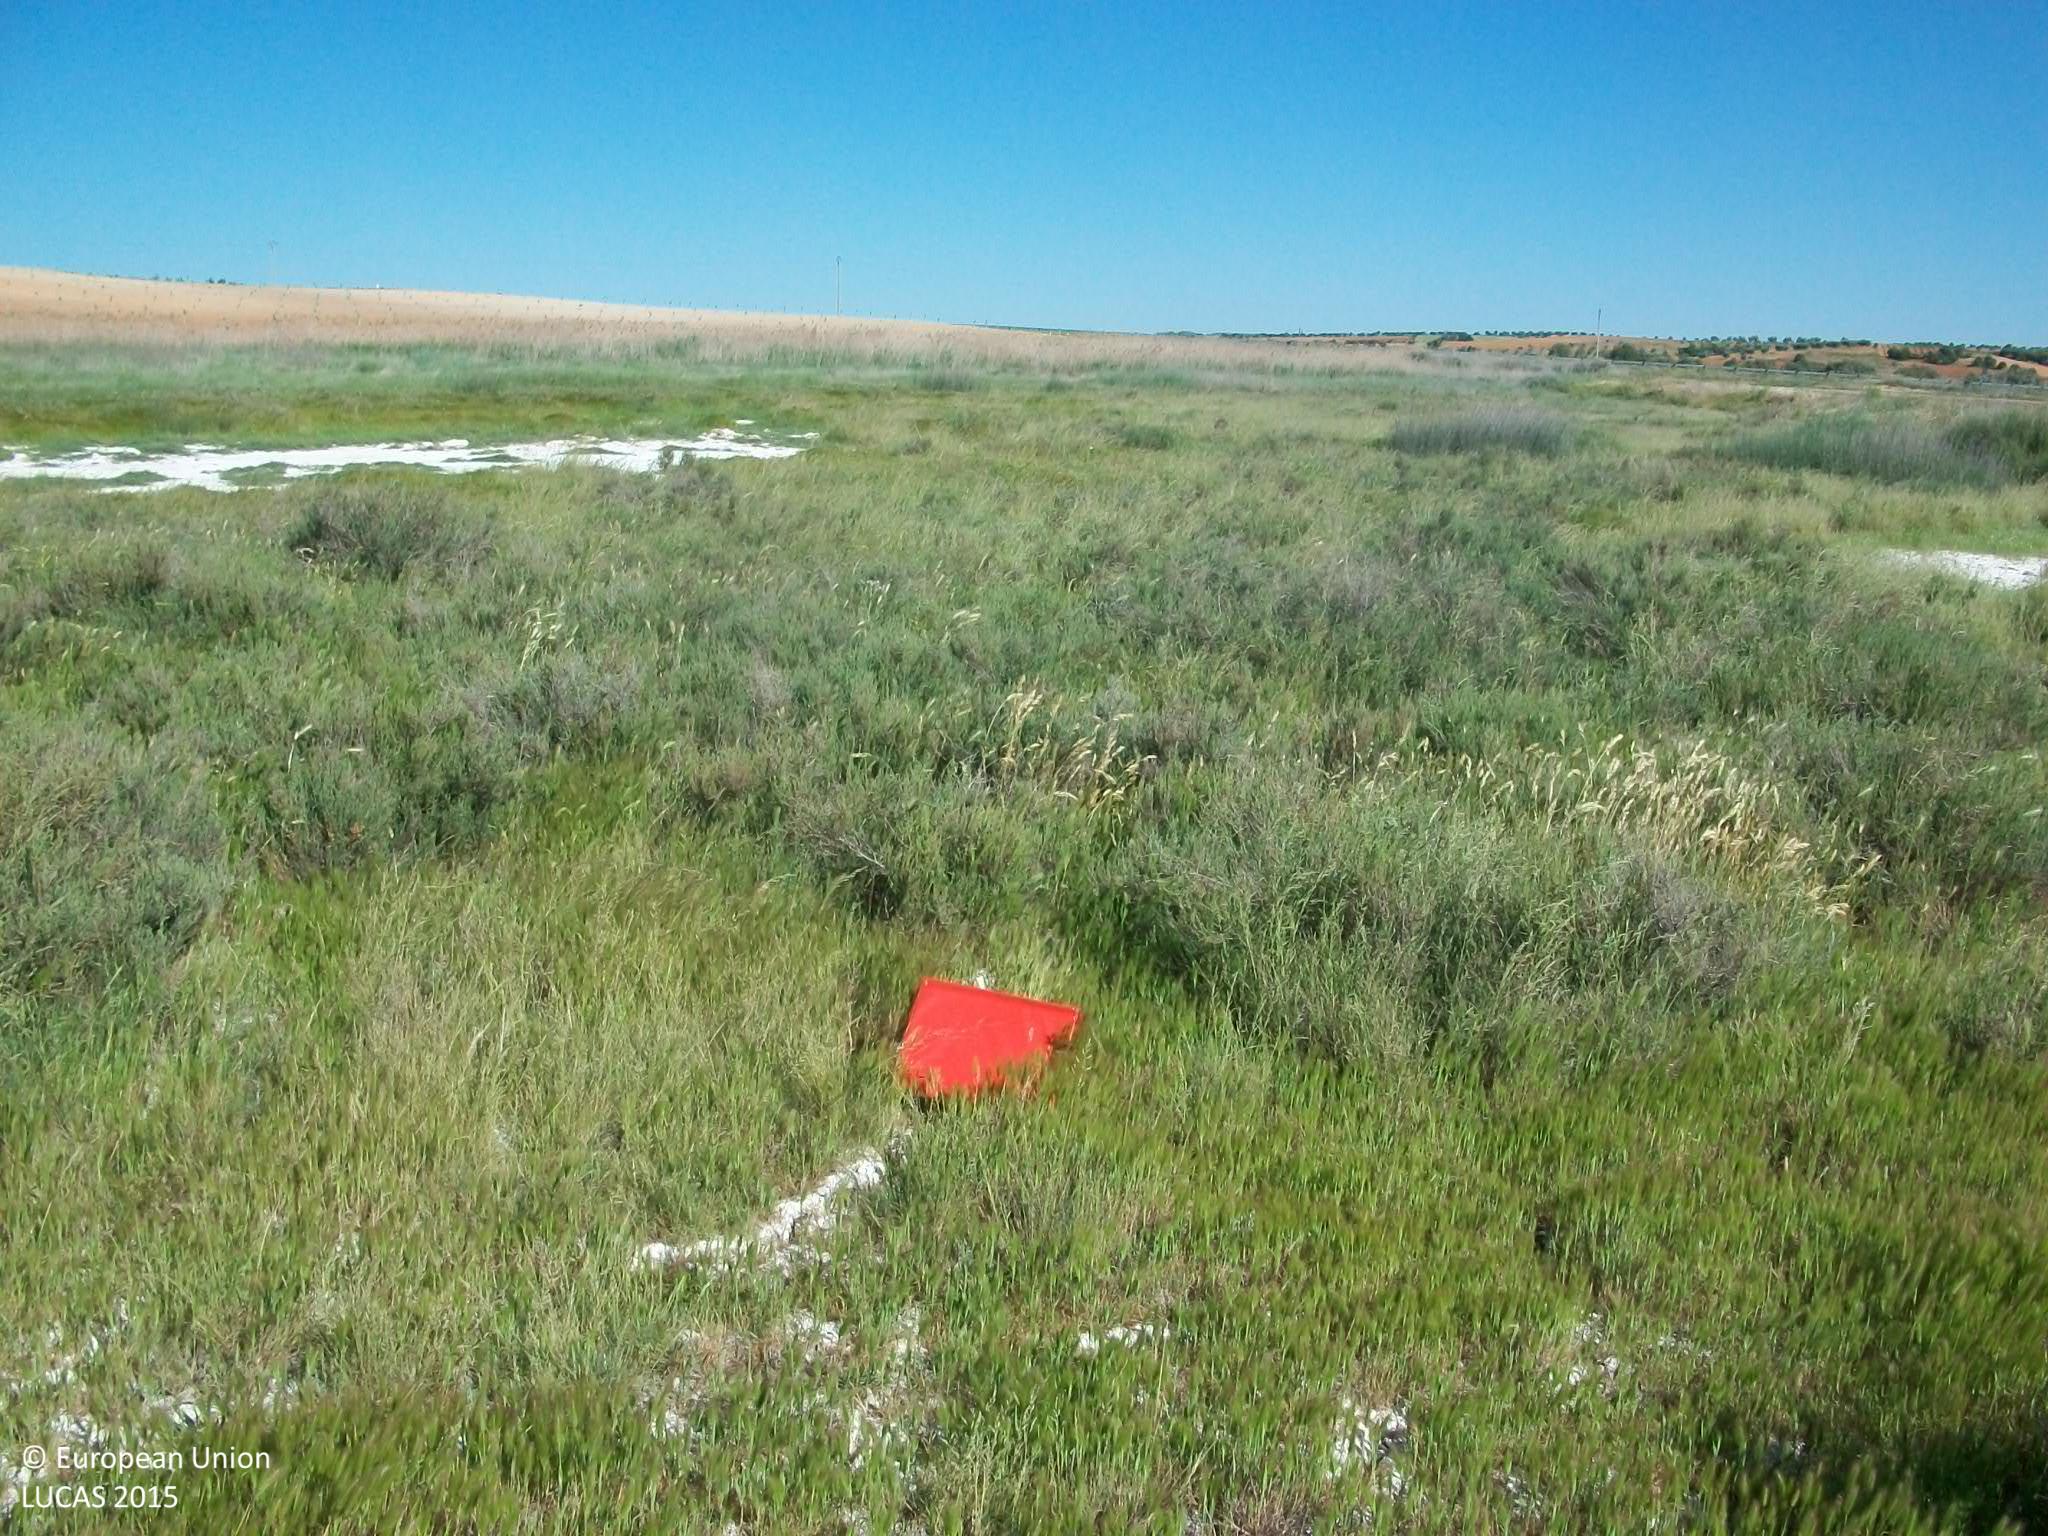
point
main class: Grassland
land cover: Spontaneously vegetated surfaces
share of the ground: > 75 %
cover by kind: herbaceous plants 90 %, unconsolidated bare surface 10 %
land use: Semi-natural and natural areas not in use
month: May
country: ES
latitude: 39.8406
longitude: -3.6435
